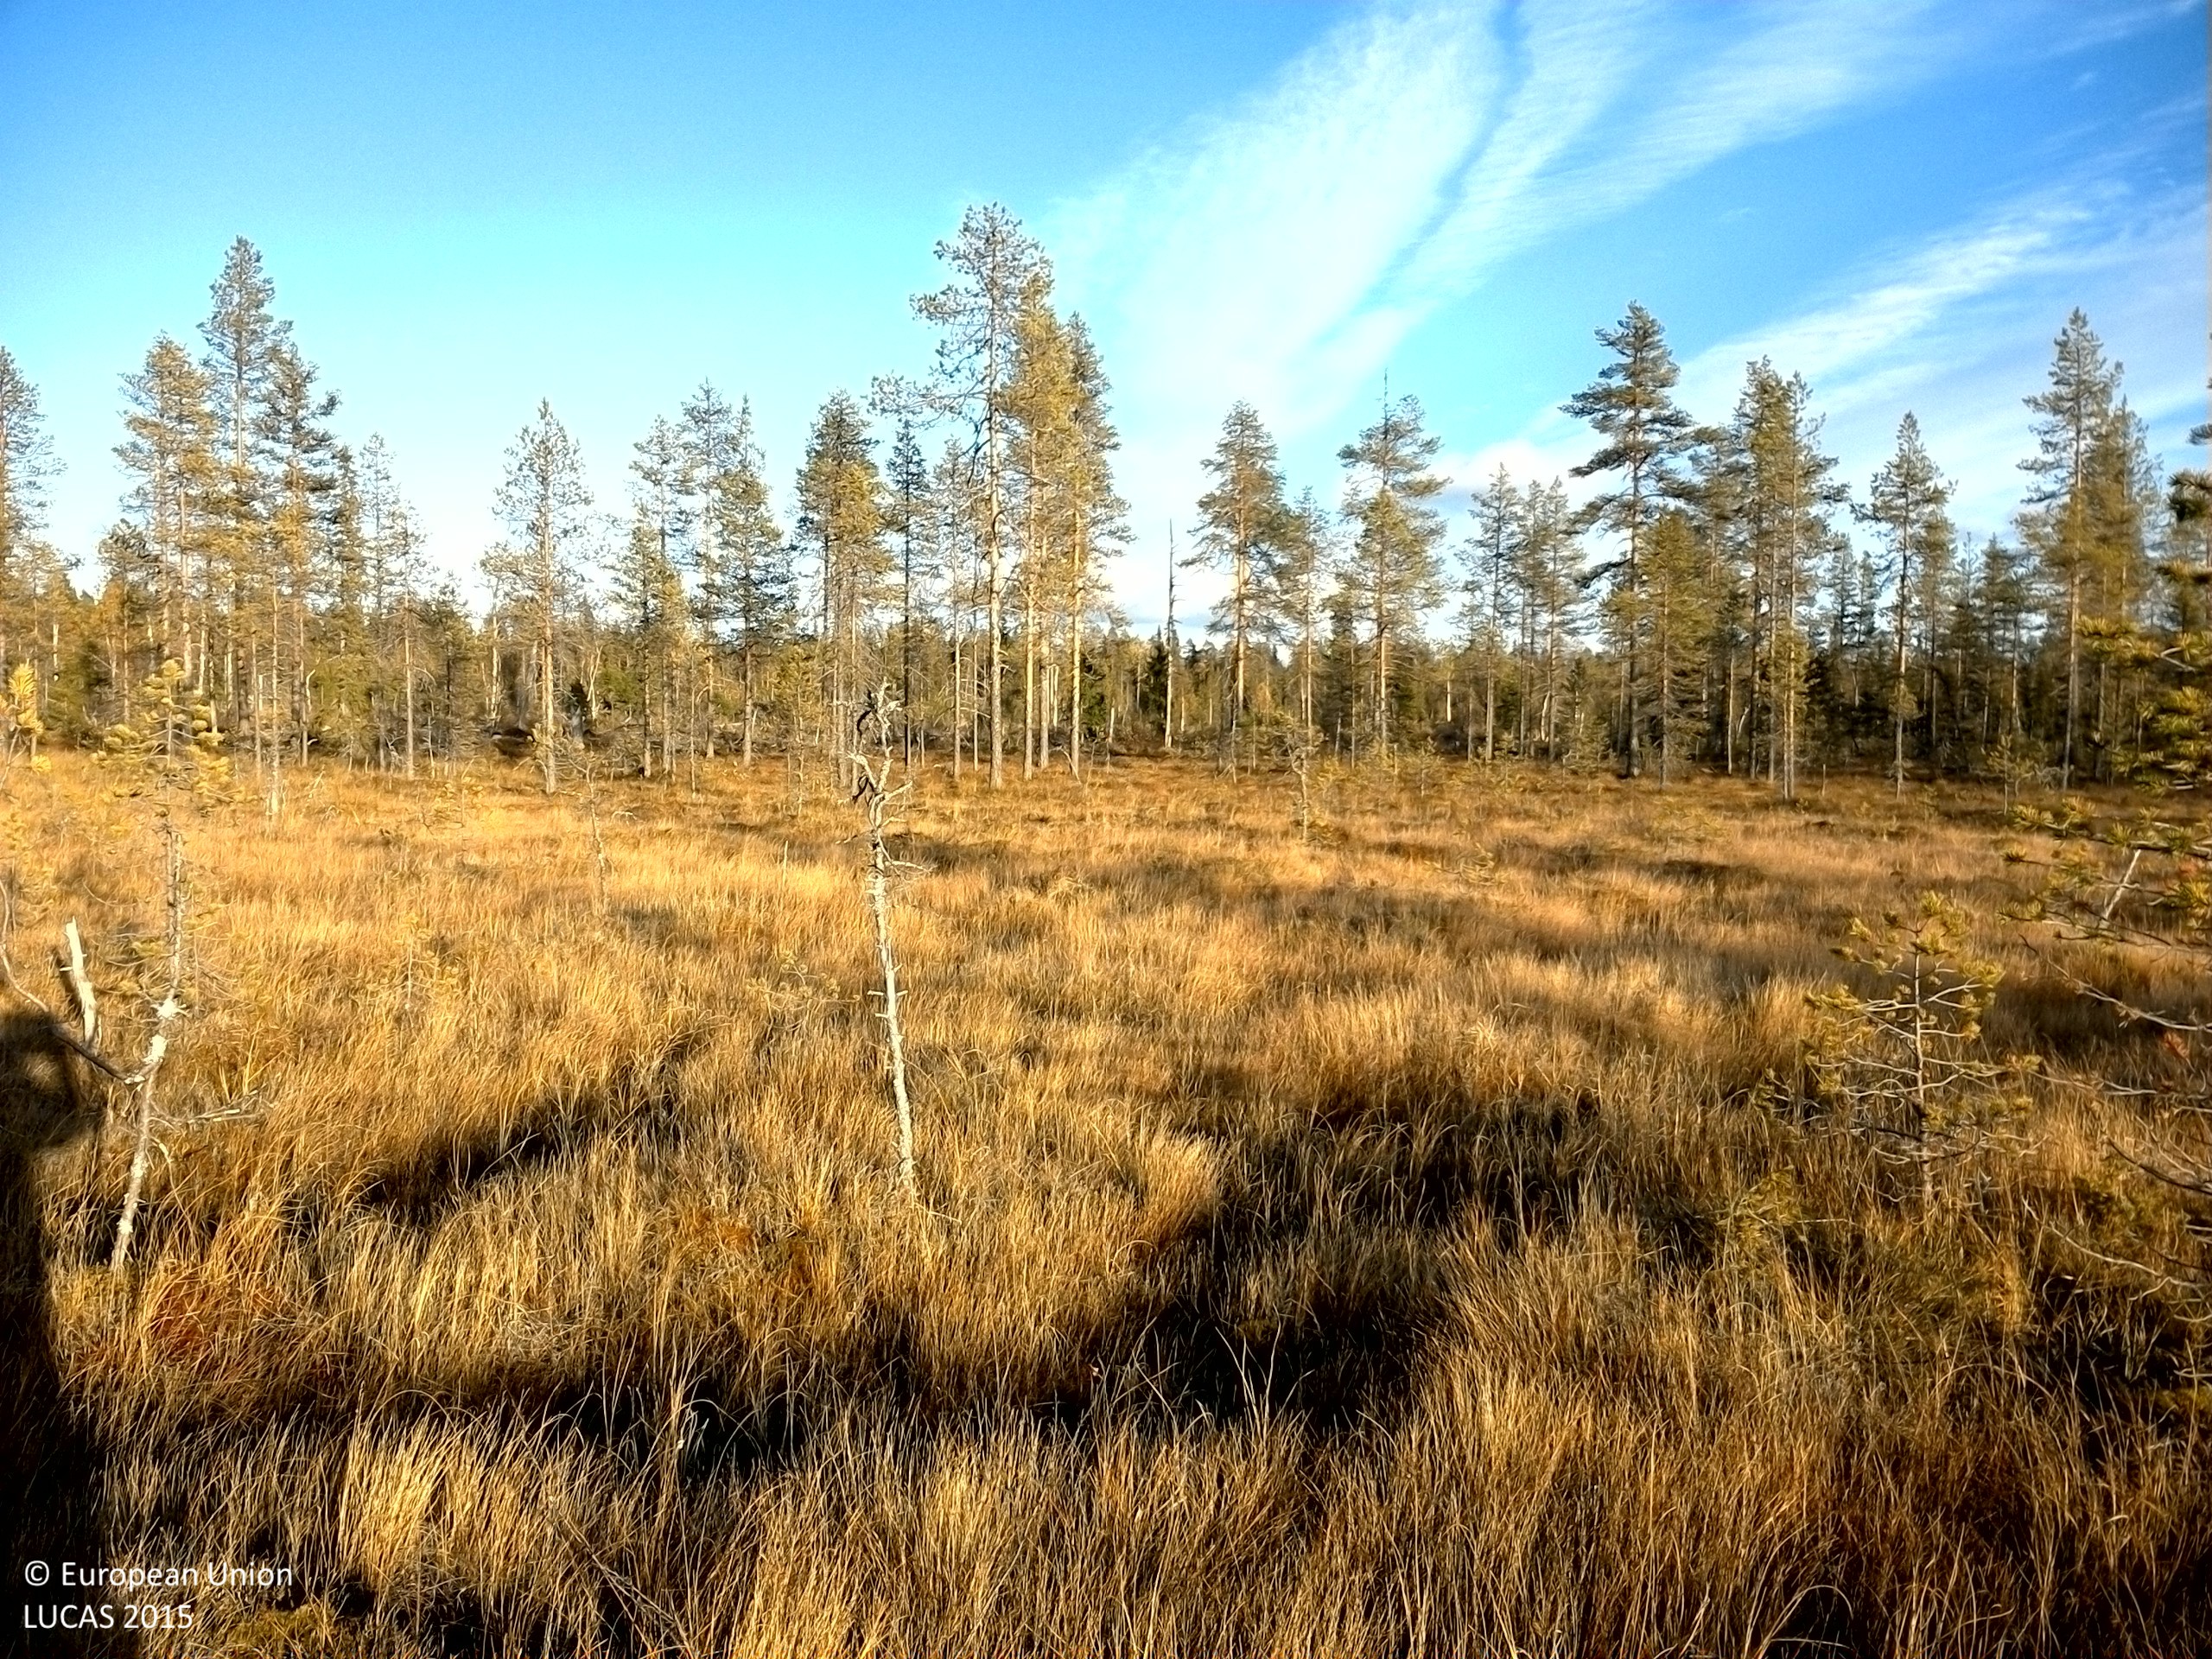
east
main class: Woodland
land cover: Pine dominated coniferous woodland
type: mire and swamp forests
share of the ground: 10 - 25 %
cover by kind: herbaceous plants 50 %, lichens and mosses 35 %, coniferous forest trees 10 %, shrubs 5 %
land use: Semi-natural and natural areas not in use
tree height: < 5 m
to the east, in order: Pine dominated coniferous woodland; Shrubland with sparse tree cover; Spruce dominated mixed woodland
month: October
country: SE
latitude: 64.4232
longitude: 15.6791
